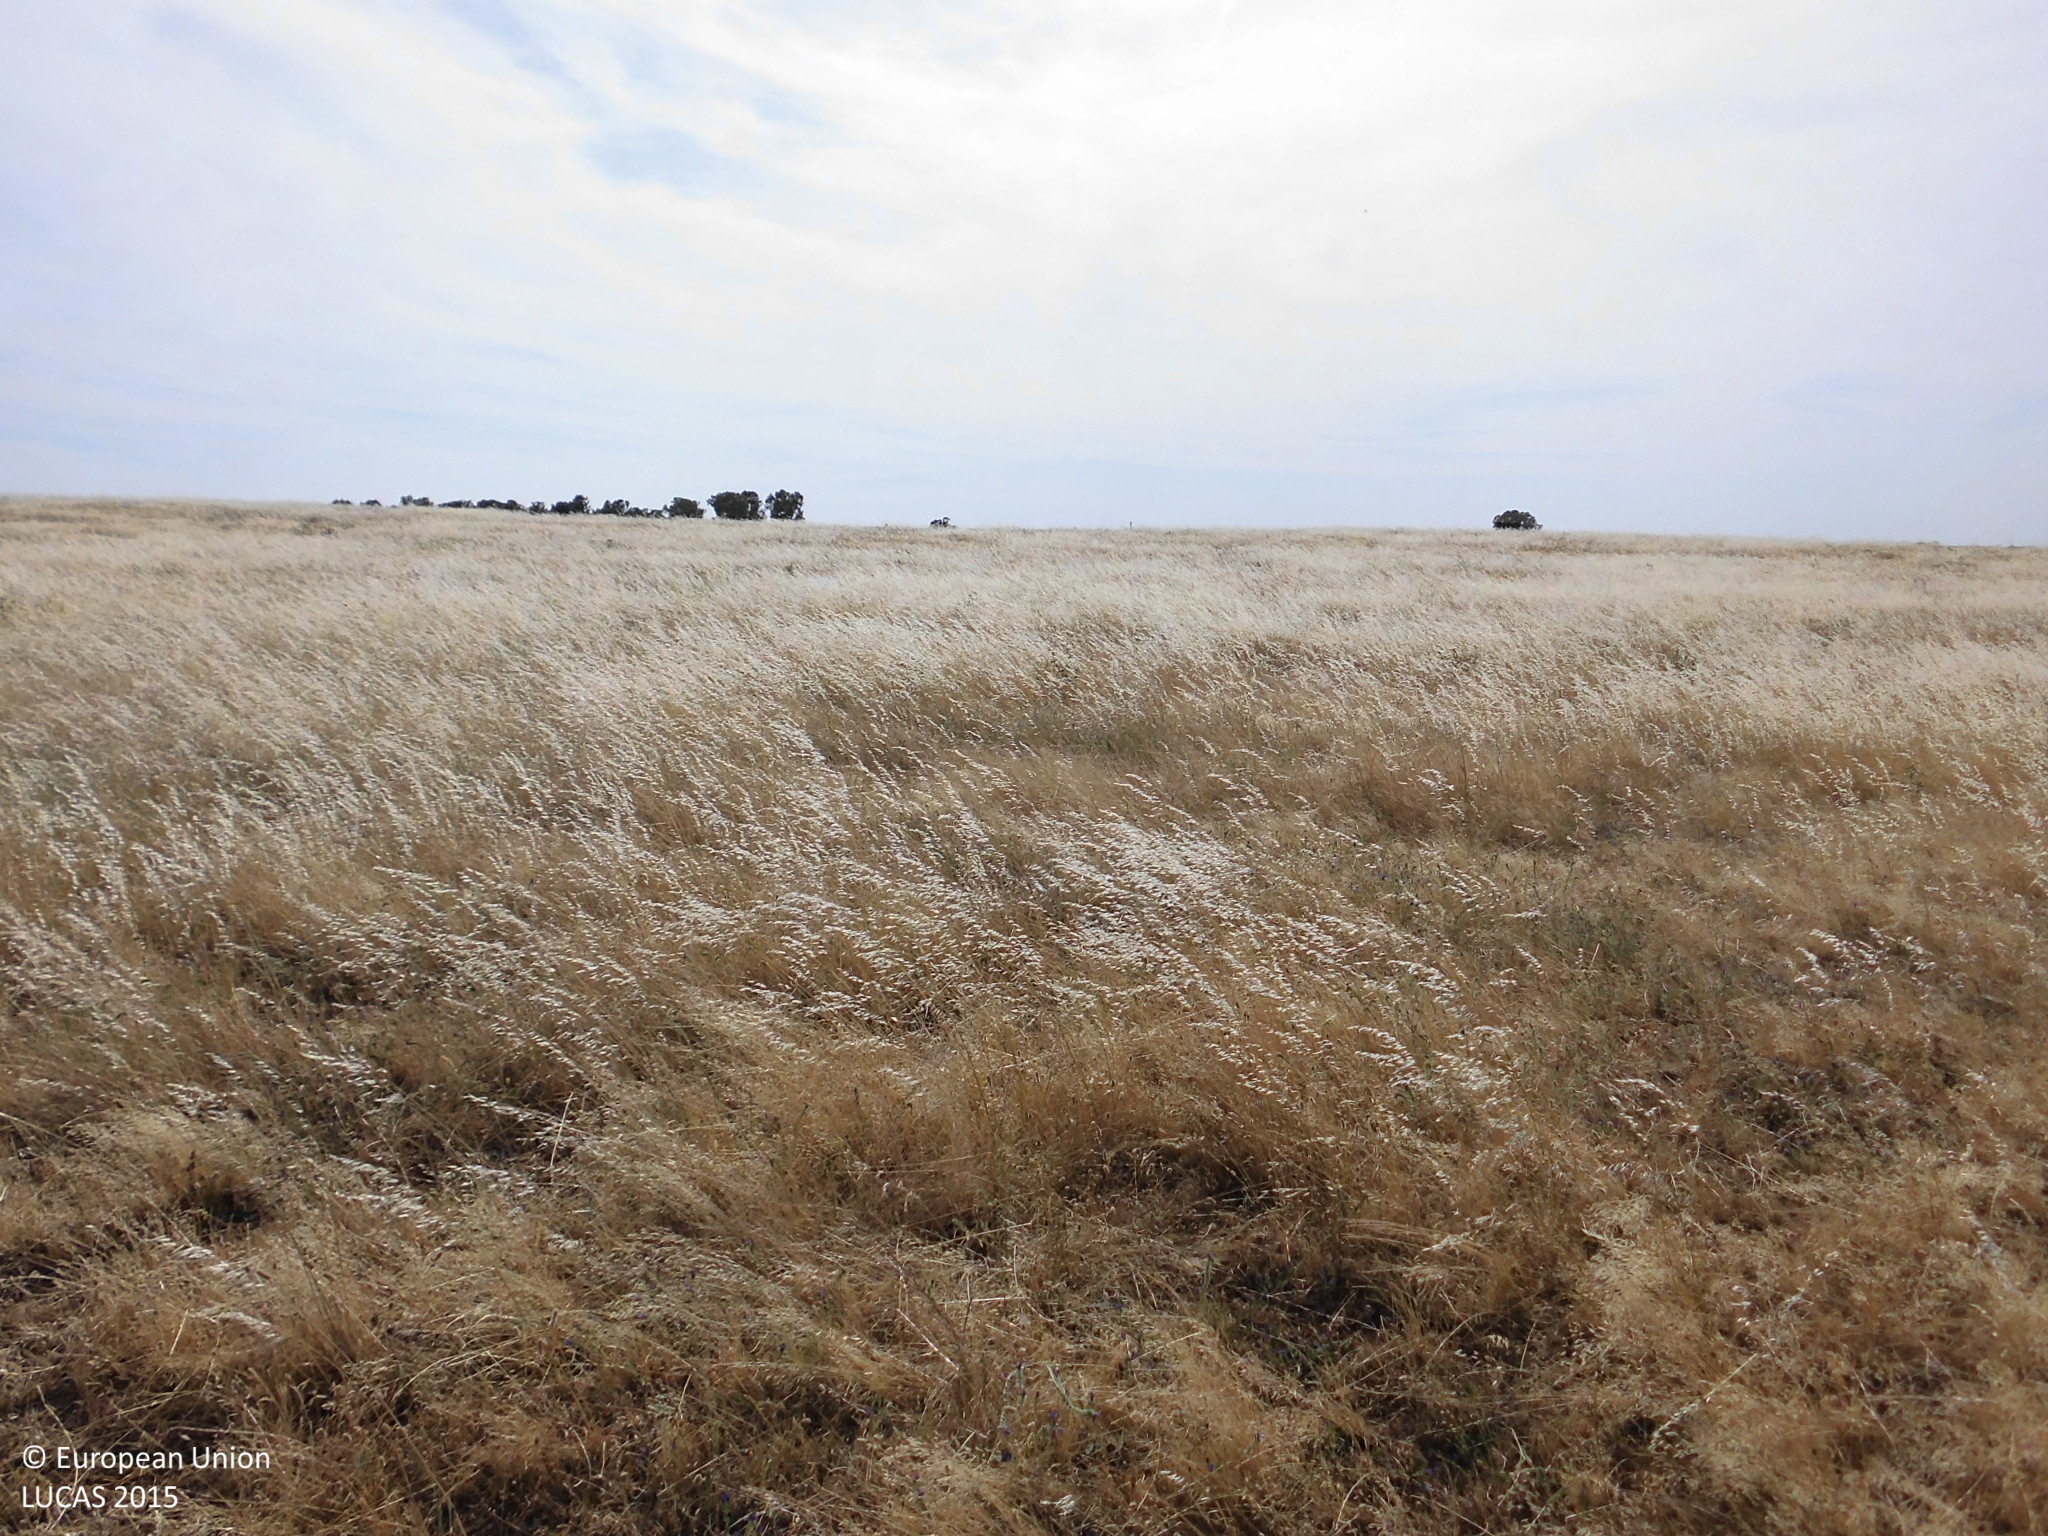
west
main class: Grassland
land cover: Grassland without tree/shrub cover
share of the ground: > 75 %
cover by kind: herbaceous plants 100 %
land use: Agriculture (excluding fallow land and kitchen gardens)
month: May
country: ES
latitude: 39.4962
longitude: -6.0035
